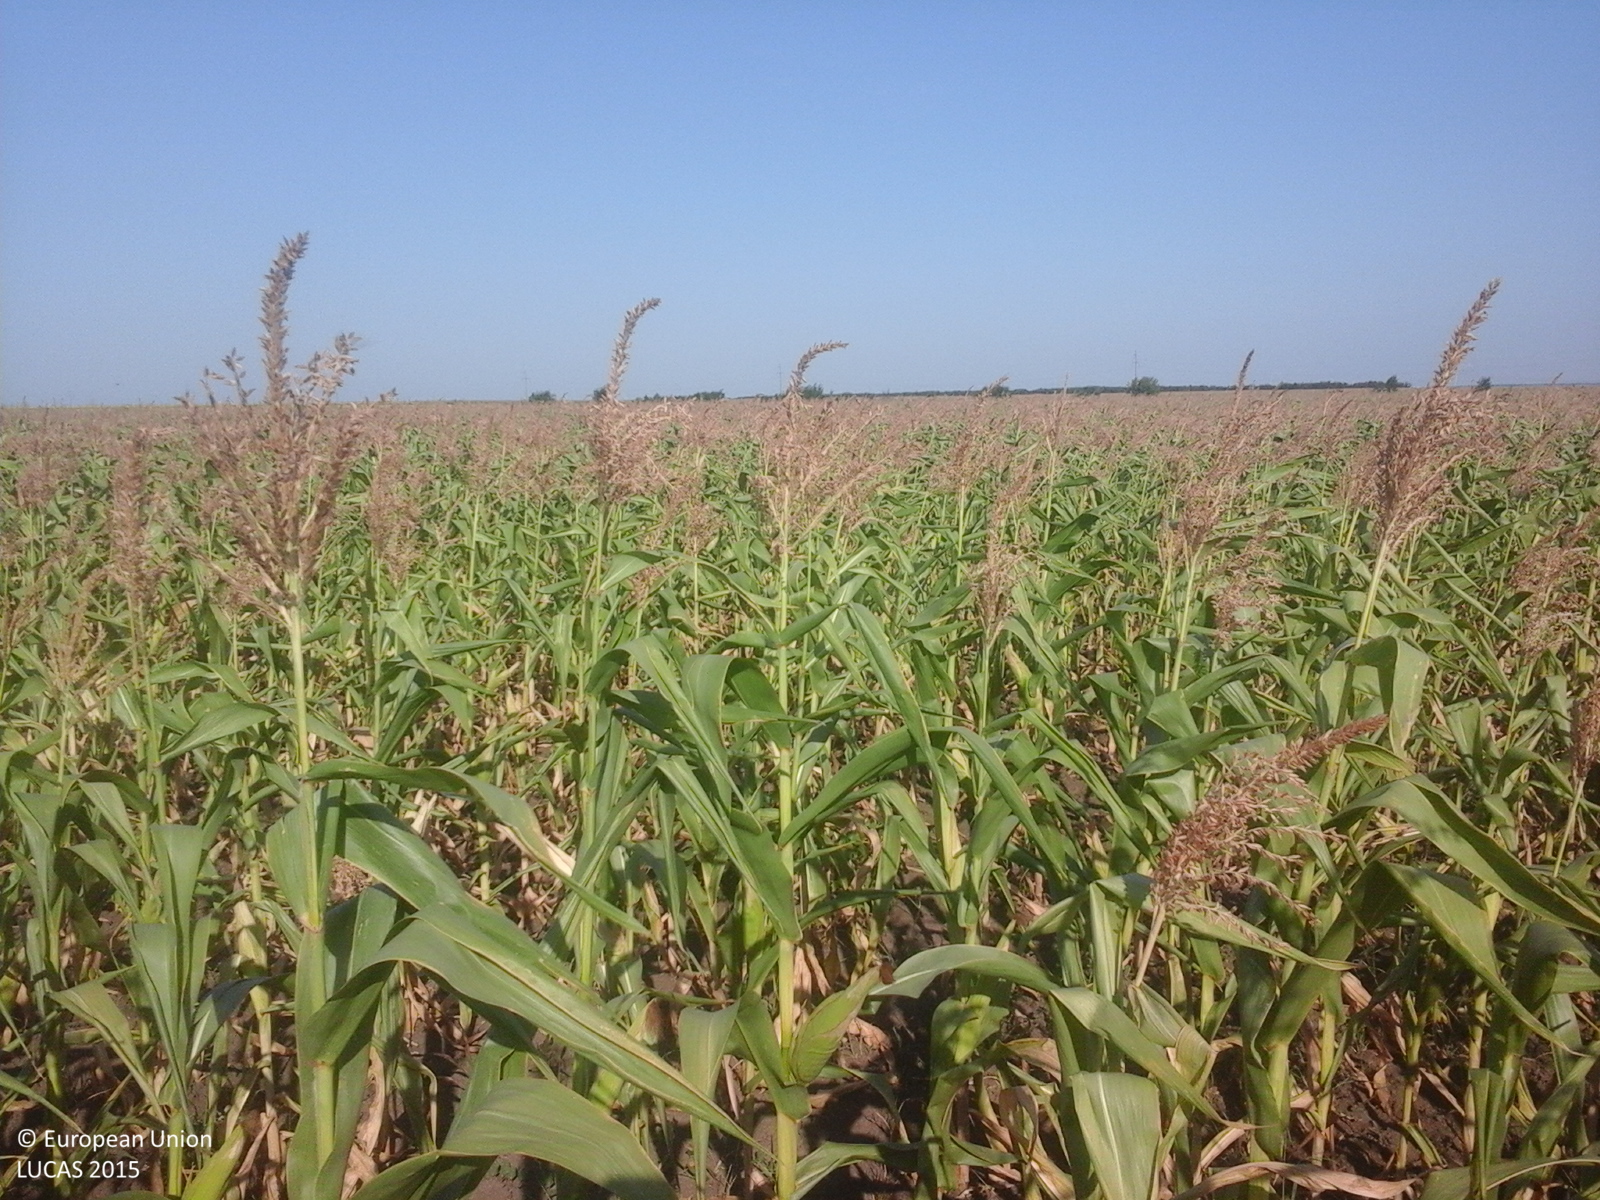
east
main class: Cropland
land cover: Maize
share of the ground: > 75 %
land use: Agriculture (excluding fallow land and kitchen gardens)
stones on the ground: < 10 %
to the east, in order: Maize; Common wheat; Other bare soil; Spontaneously vegetated surfaces; Abandoned hedges; Ditches and canals; Grass margins; Tracks; Common wheat
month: August
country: RO
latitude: 45.0712
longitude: 26.6502
